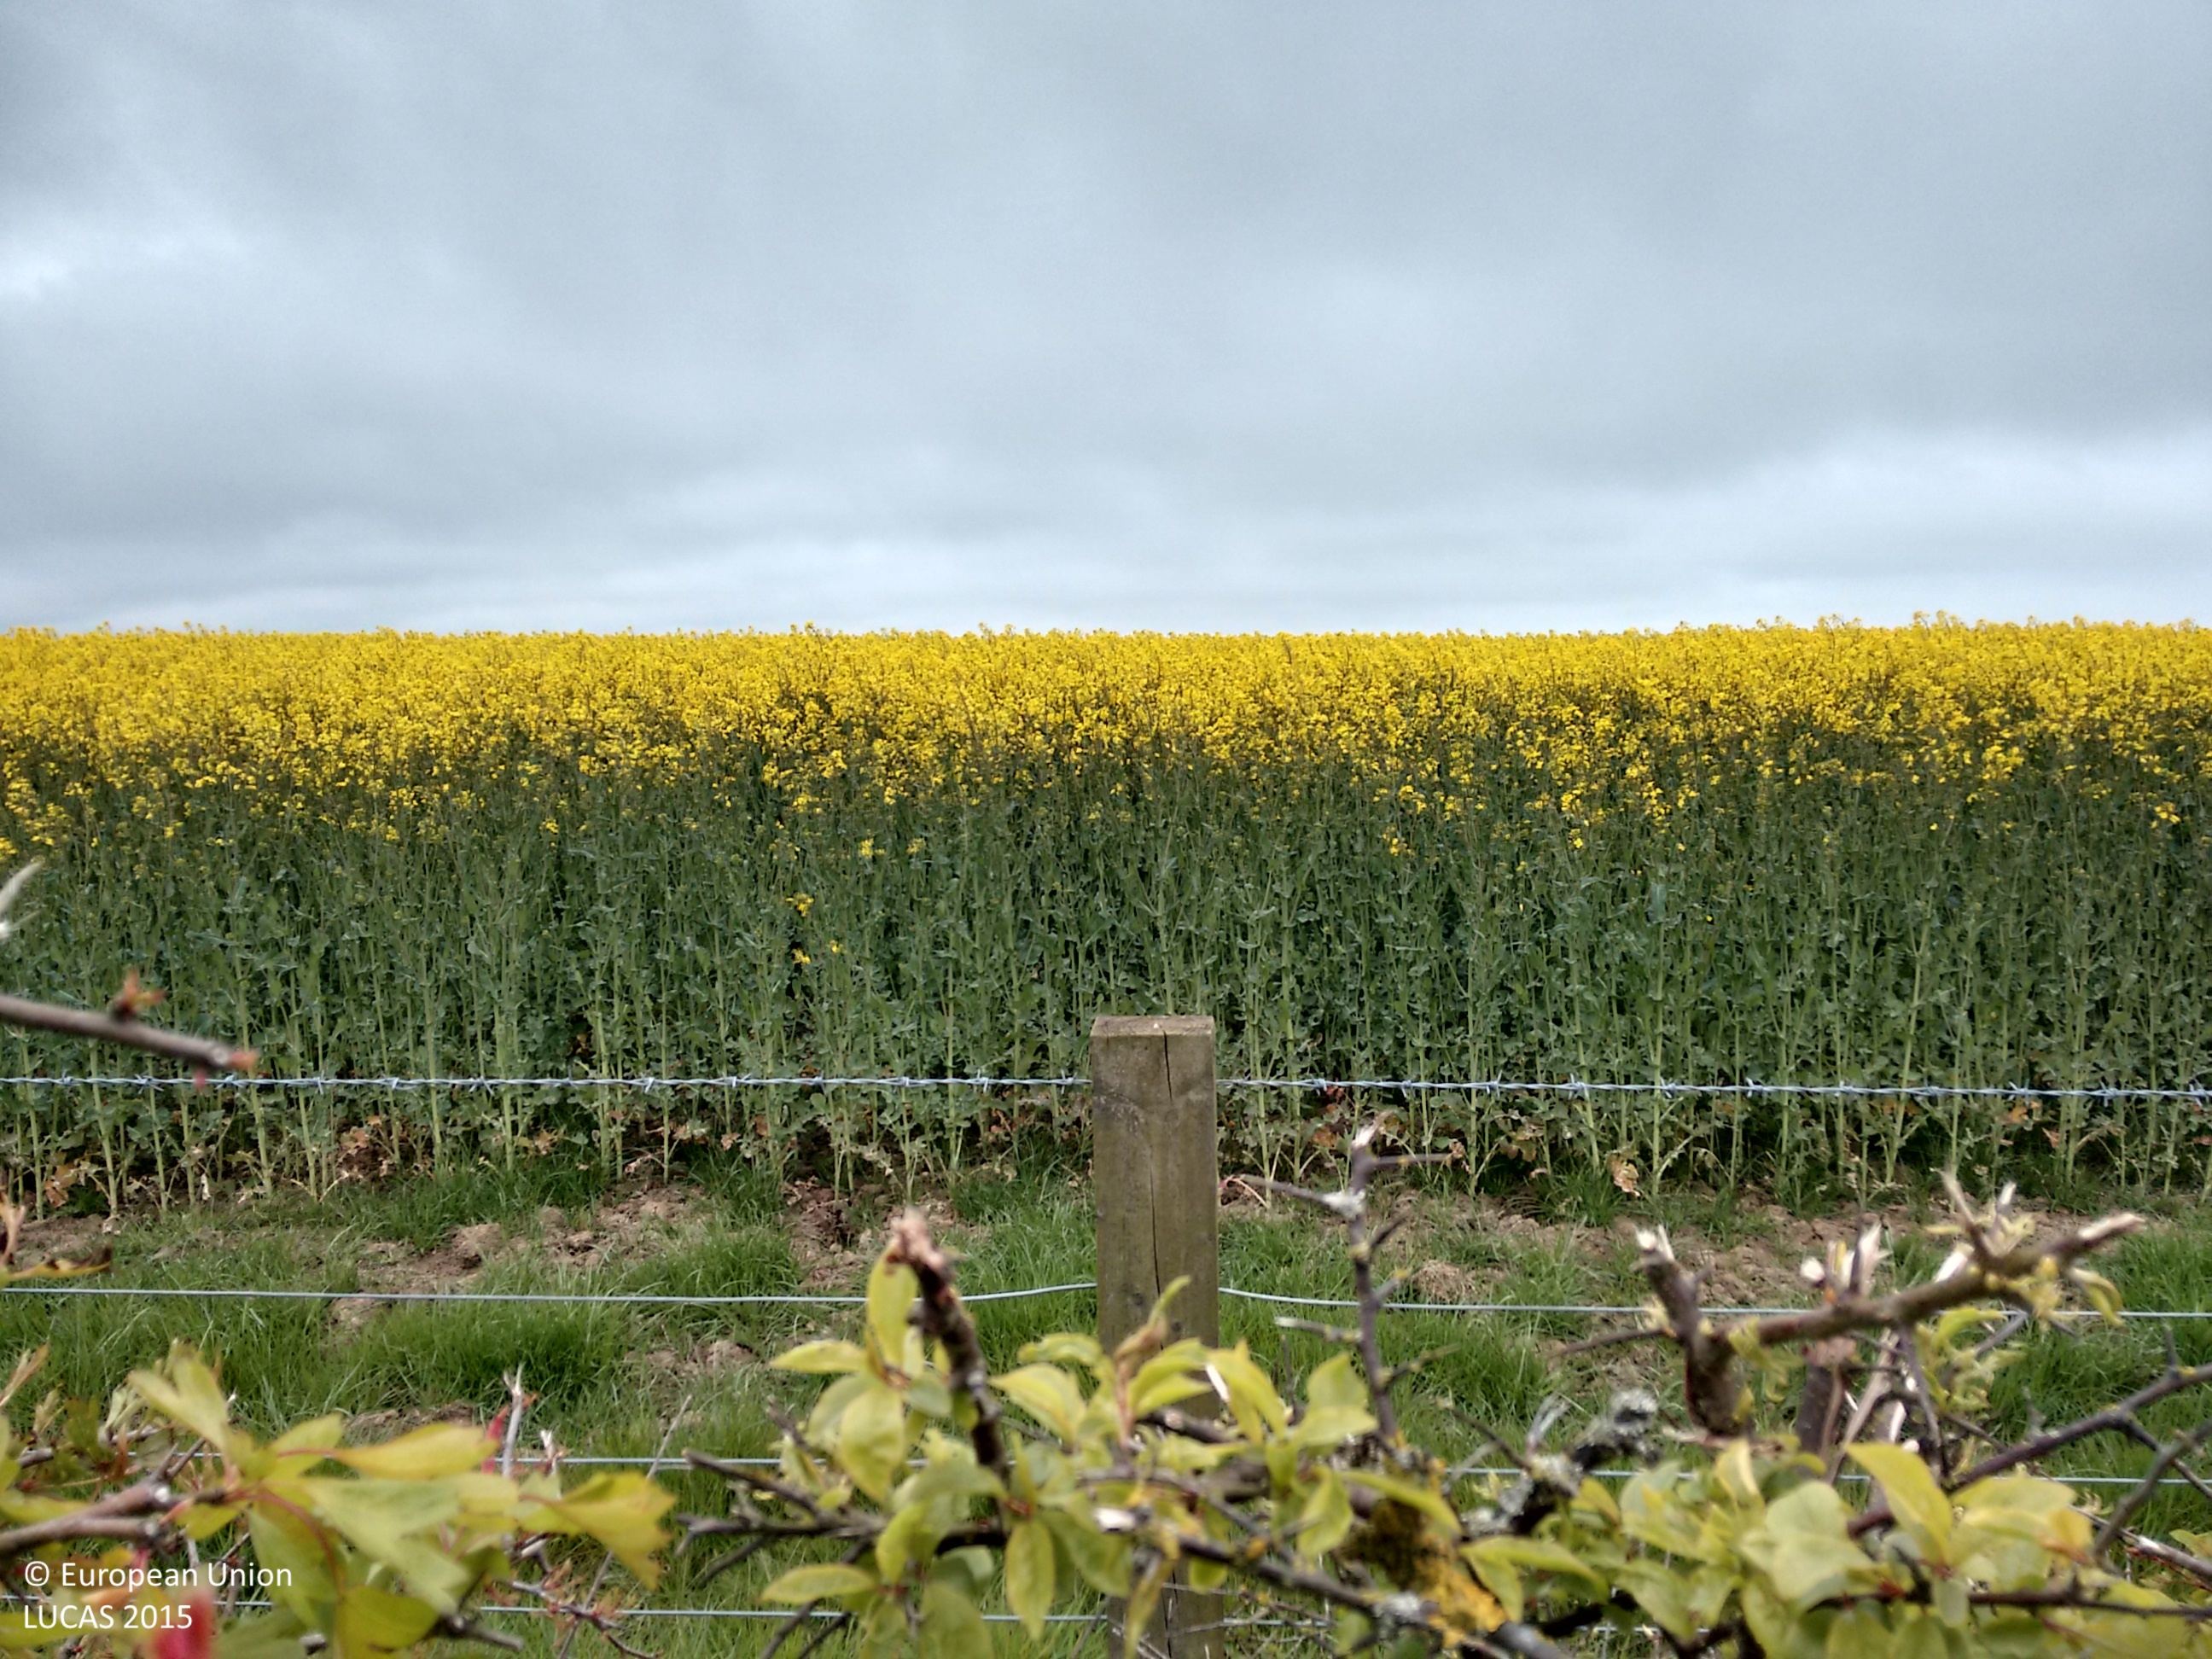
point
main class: Cropland
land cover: Rape and turnip rape
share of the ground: > 75 %
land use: Agriculture (excluding fallow land and kitchen gardens)
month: May
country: GB
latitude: 55.2790
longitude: -1.5870
